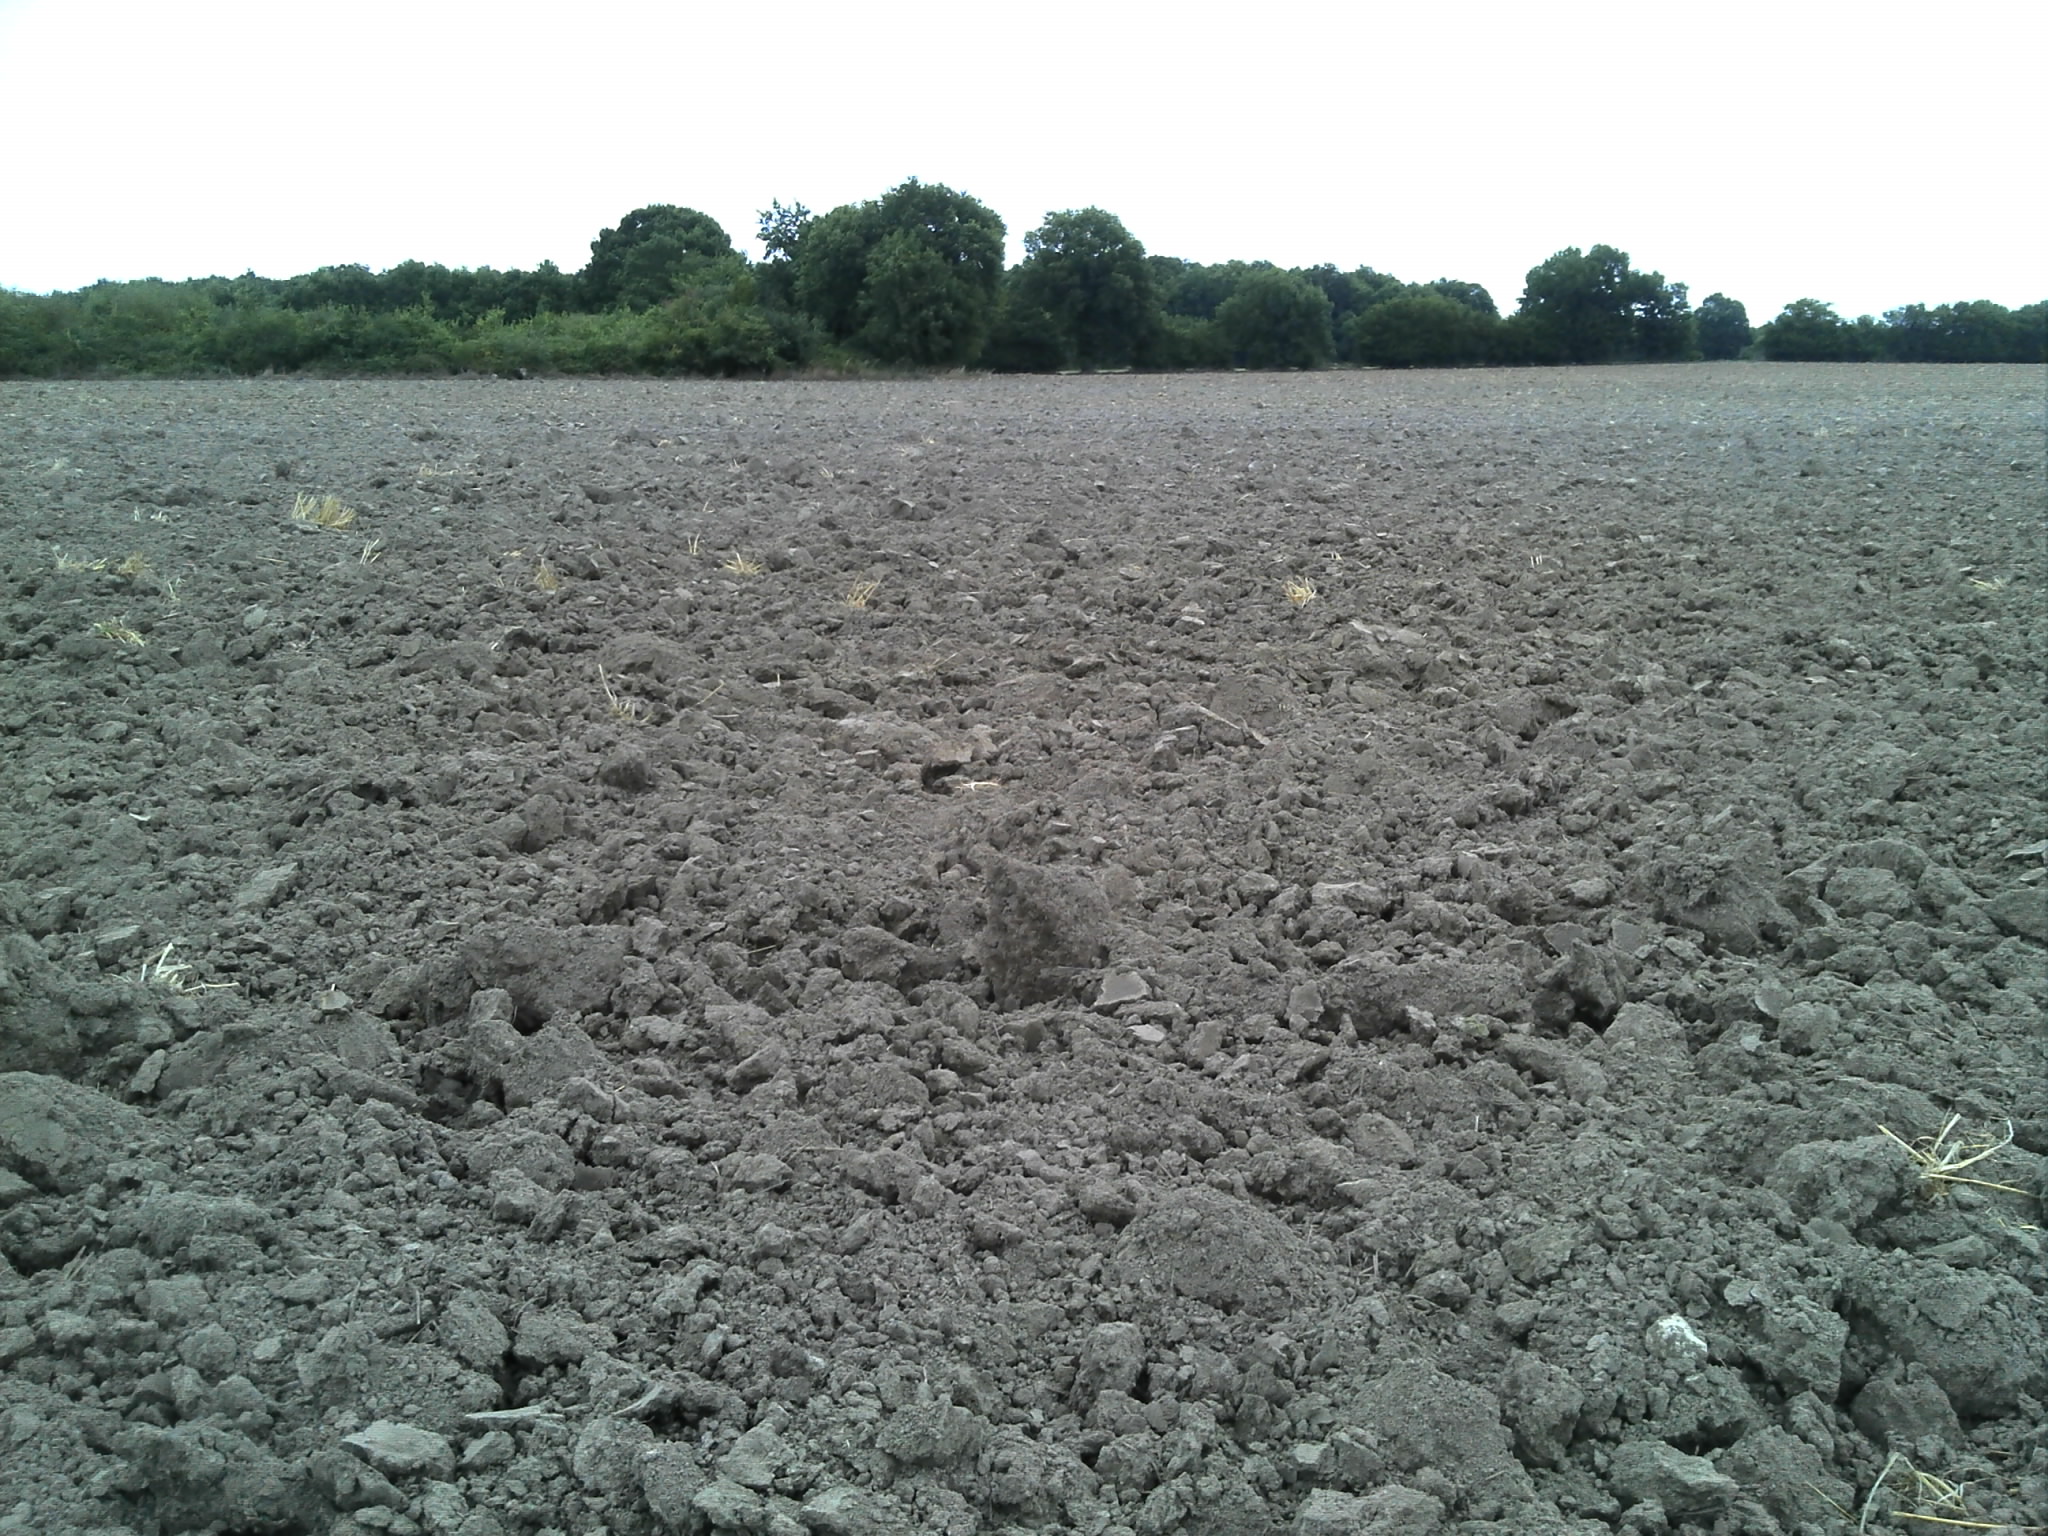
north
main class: Cropland
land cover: Barley
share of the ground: < 10 %
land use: Agriculture (excluding fallow land and kitchen gardens)
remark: Harvested field
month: July
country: FR
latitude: 46.7066
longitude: 1.5791
